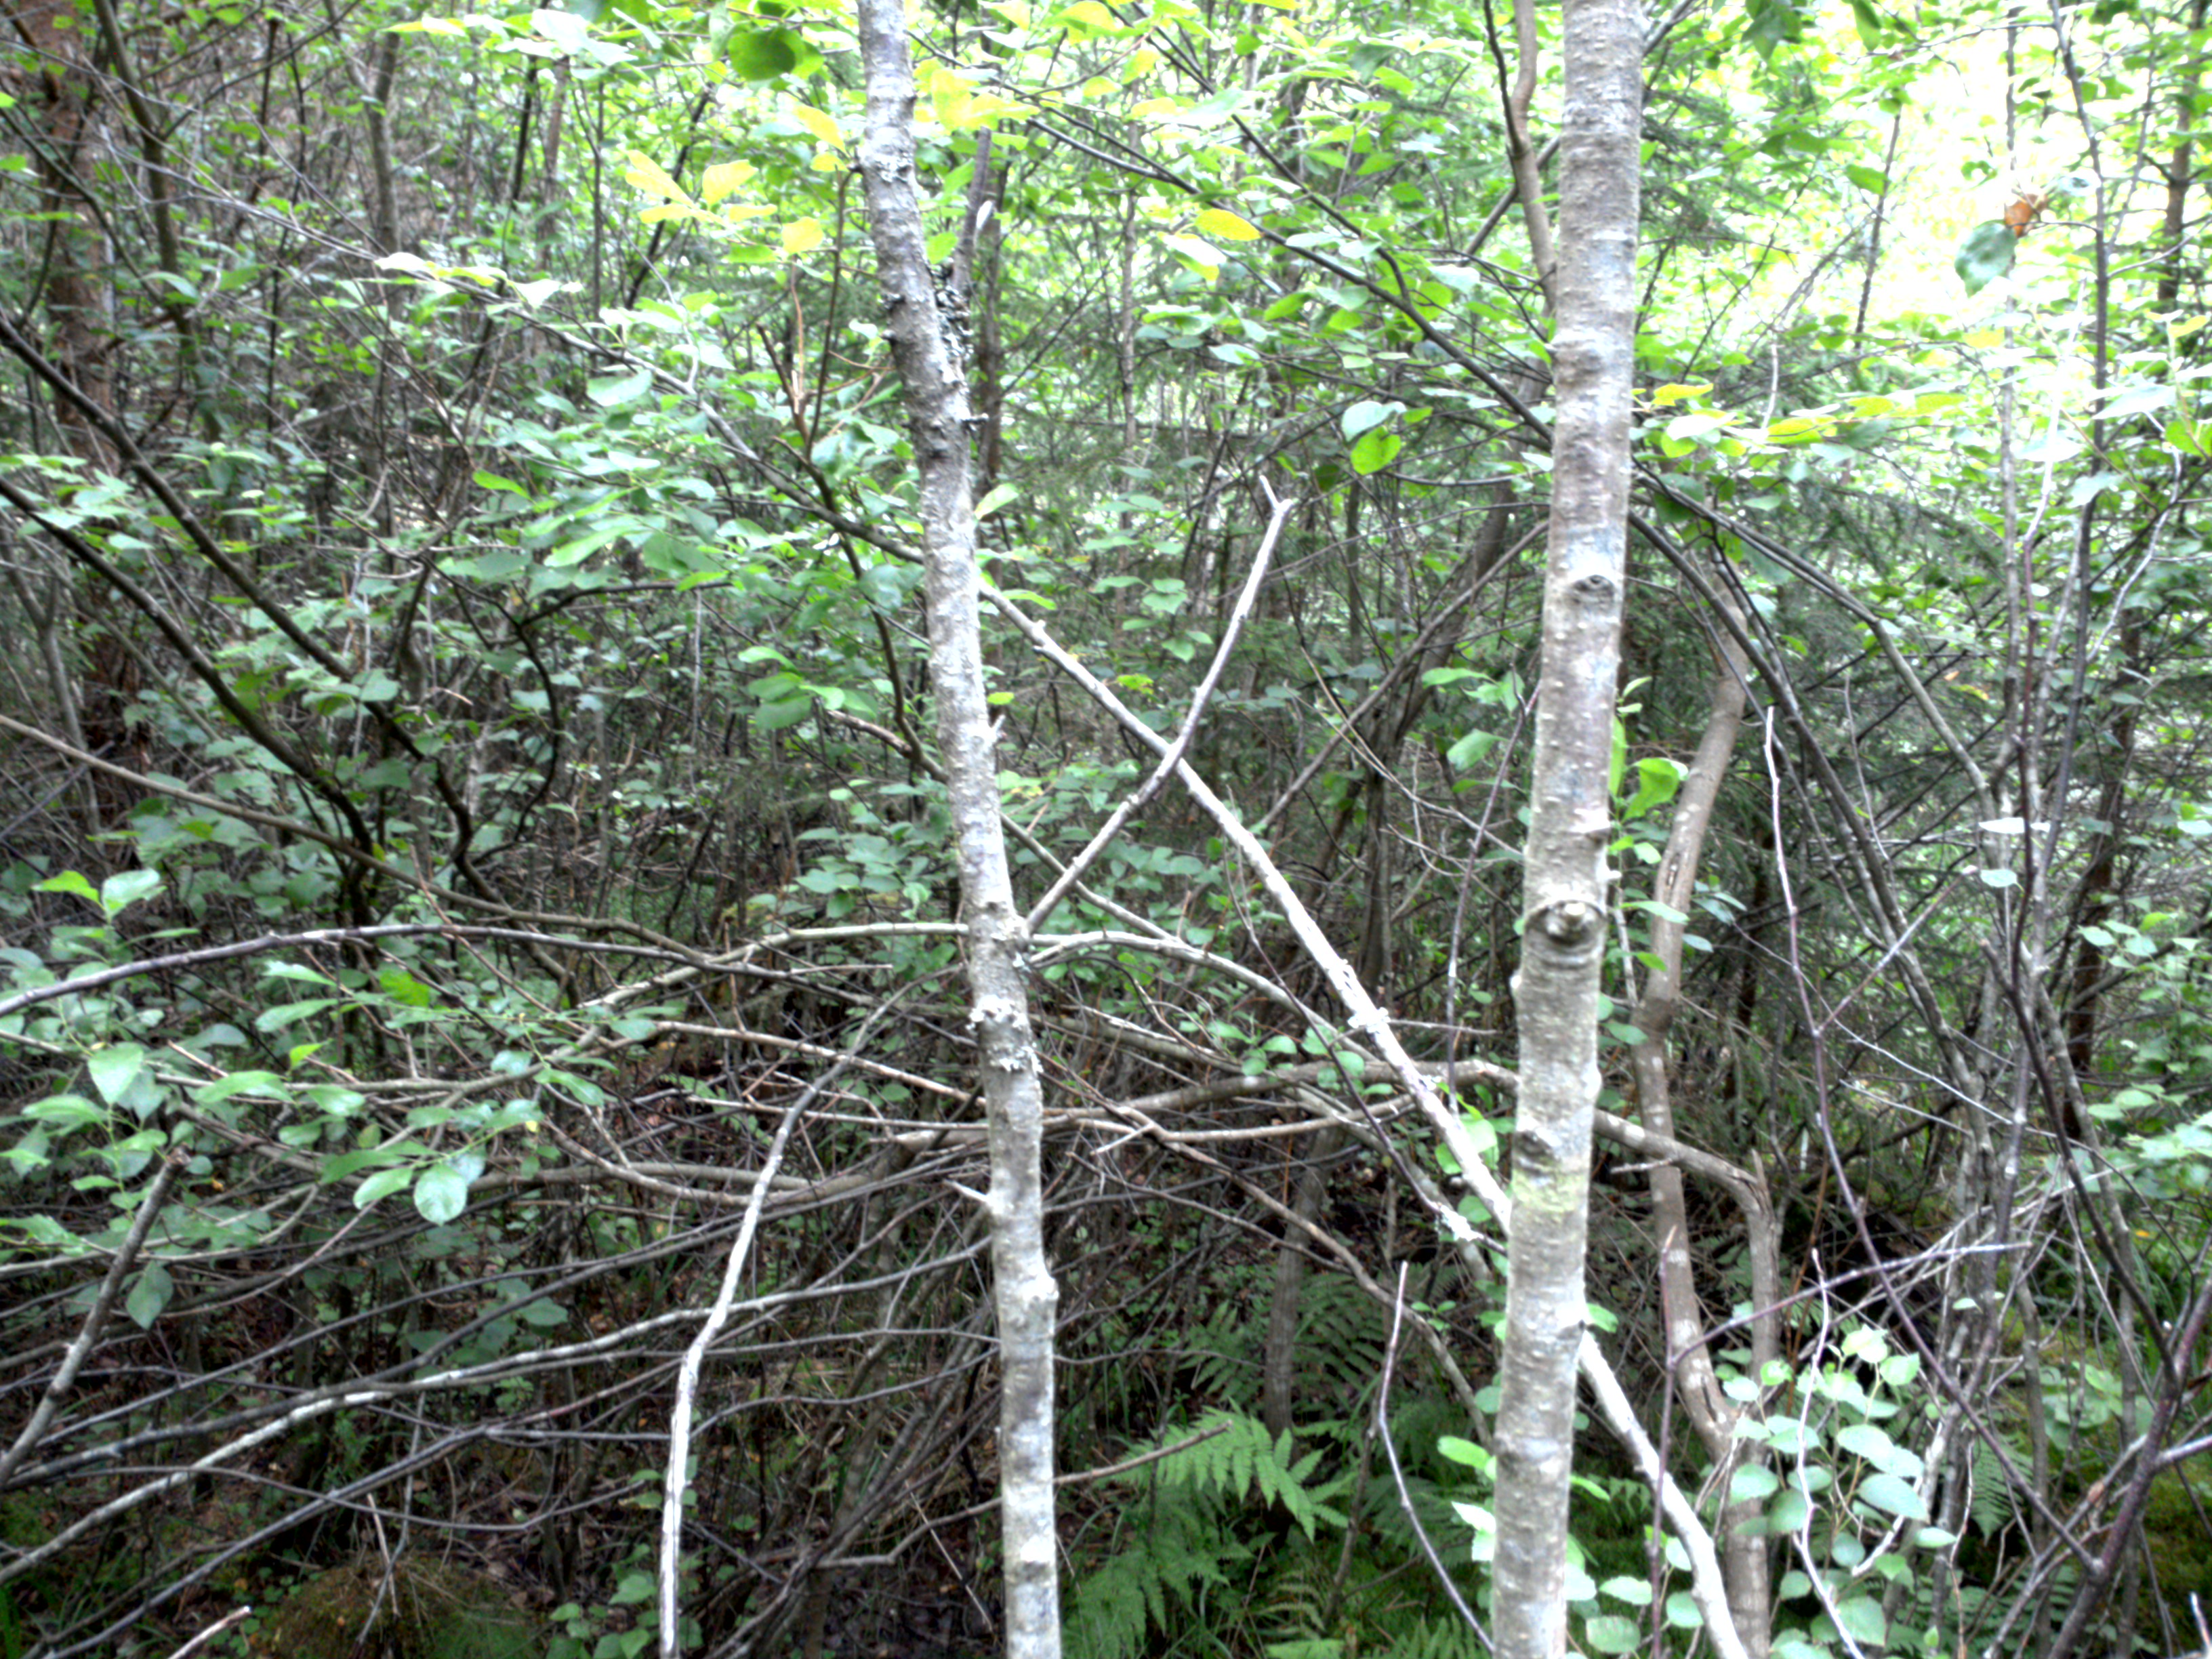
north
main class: Woodland
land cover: Spruce dominated mixed woodland
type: boreal forest
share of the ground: > 75 %
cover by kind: coniferous forest trees 50 %, broadleaved forest trees 40 %, herbaceous plants 5 %, lichens and mosses 5 %
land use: Forestry
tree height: > 5 m
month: July
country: SE
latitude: 59.1505
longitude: 18.4110
